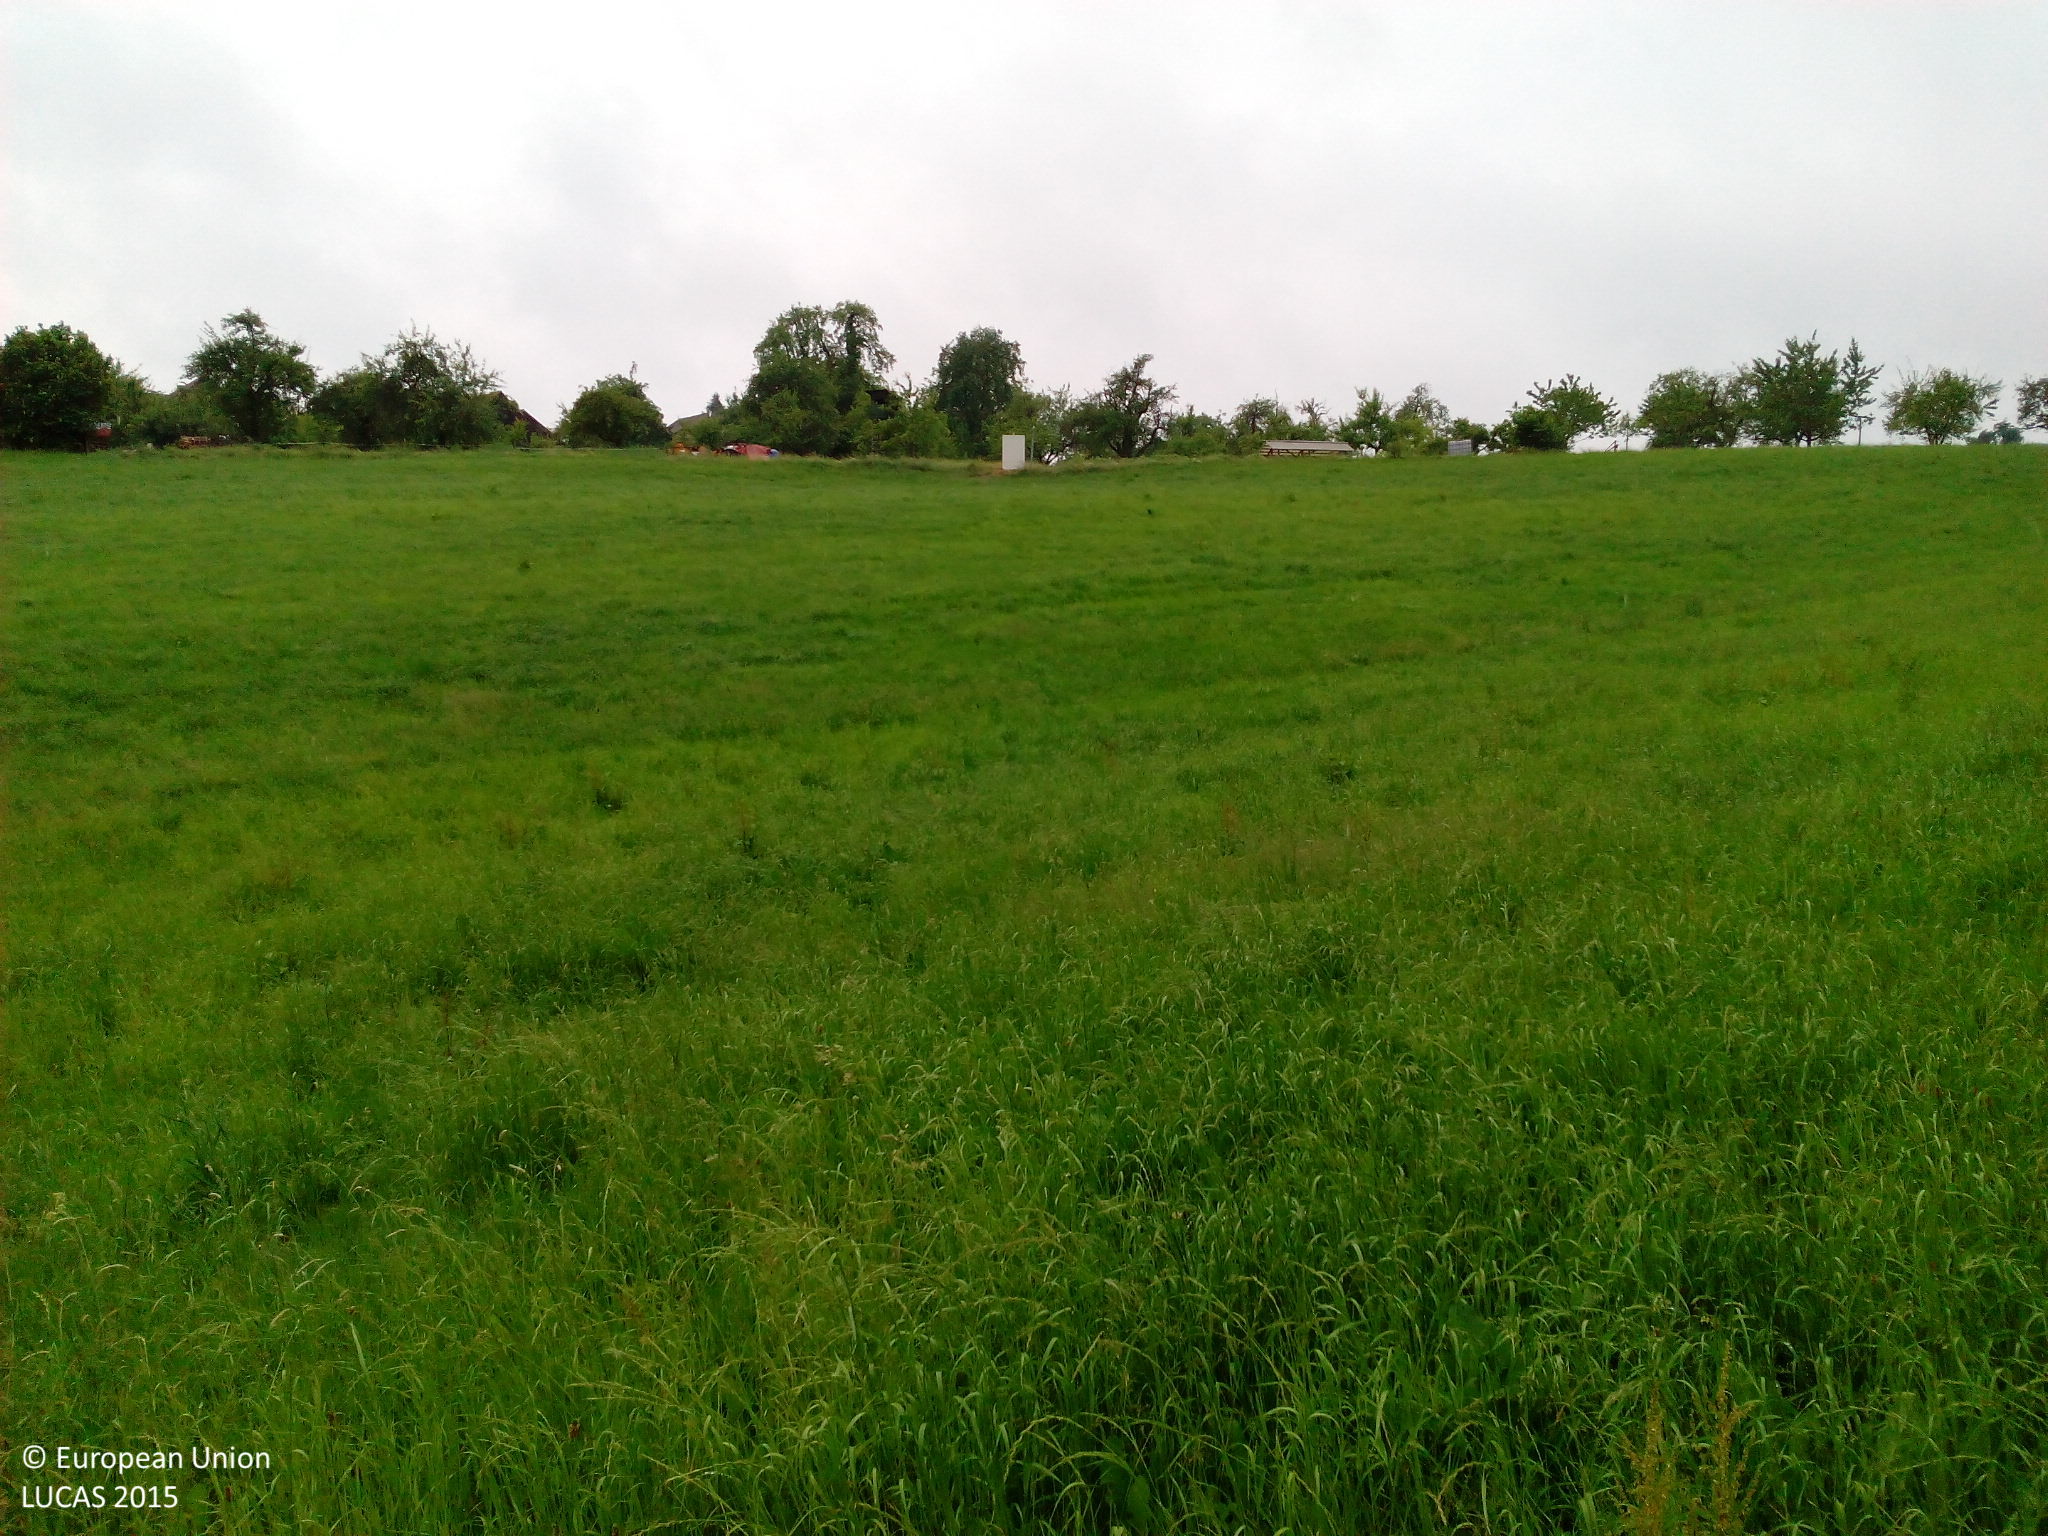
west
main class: Cropland
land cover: Nurseries
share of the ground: 25 - 50 %
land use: Forestry
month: June
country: DE
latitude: 48.8528
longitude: 9.6867
